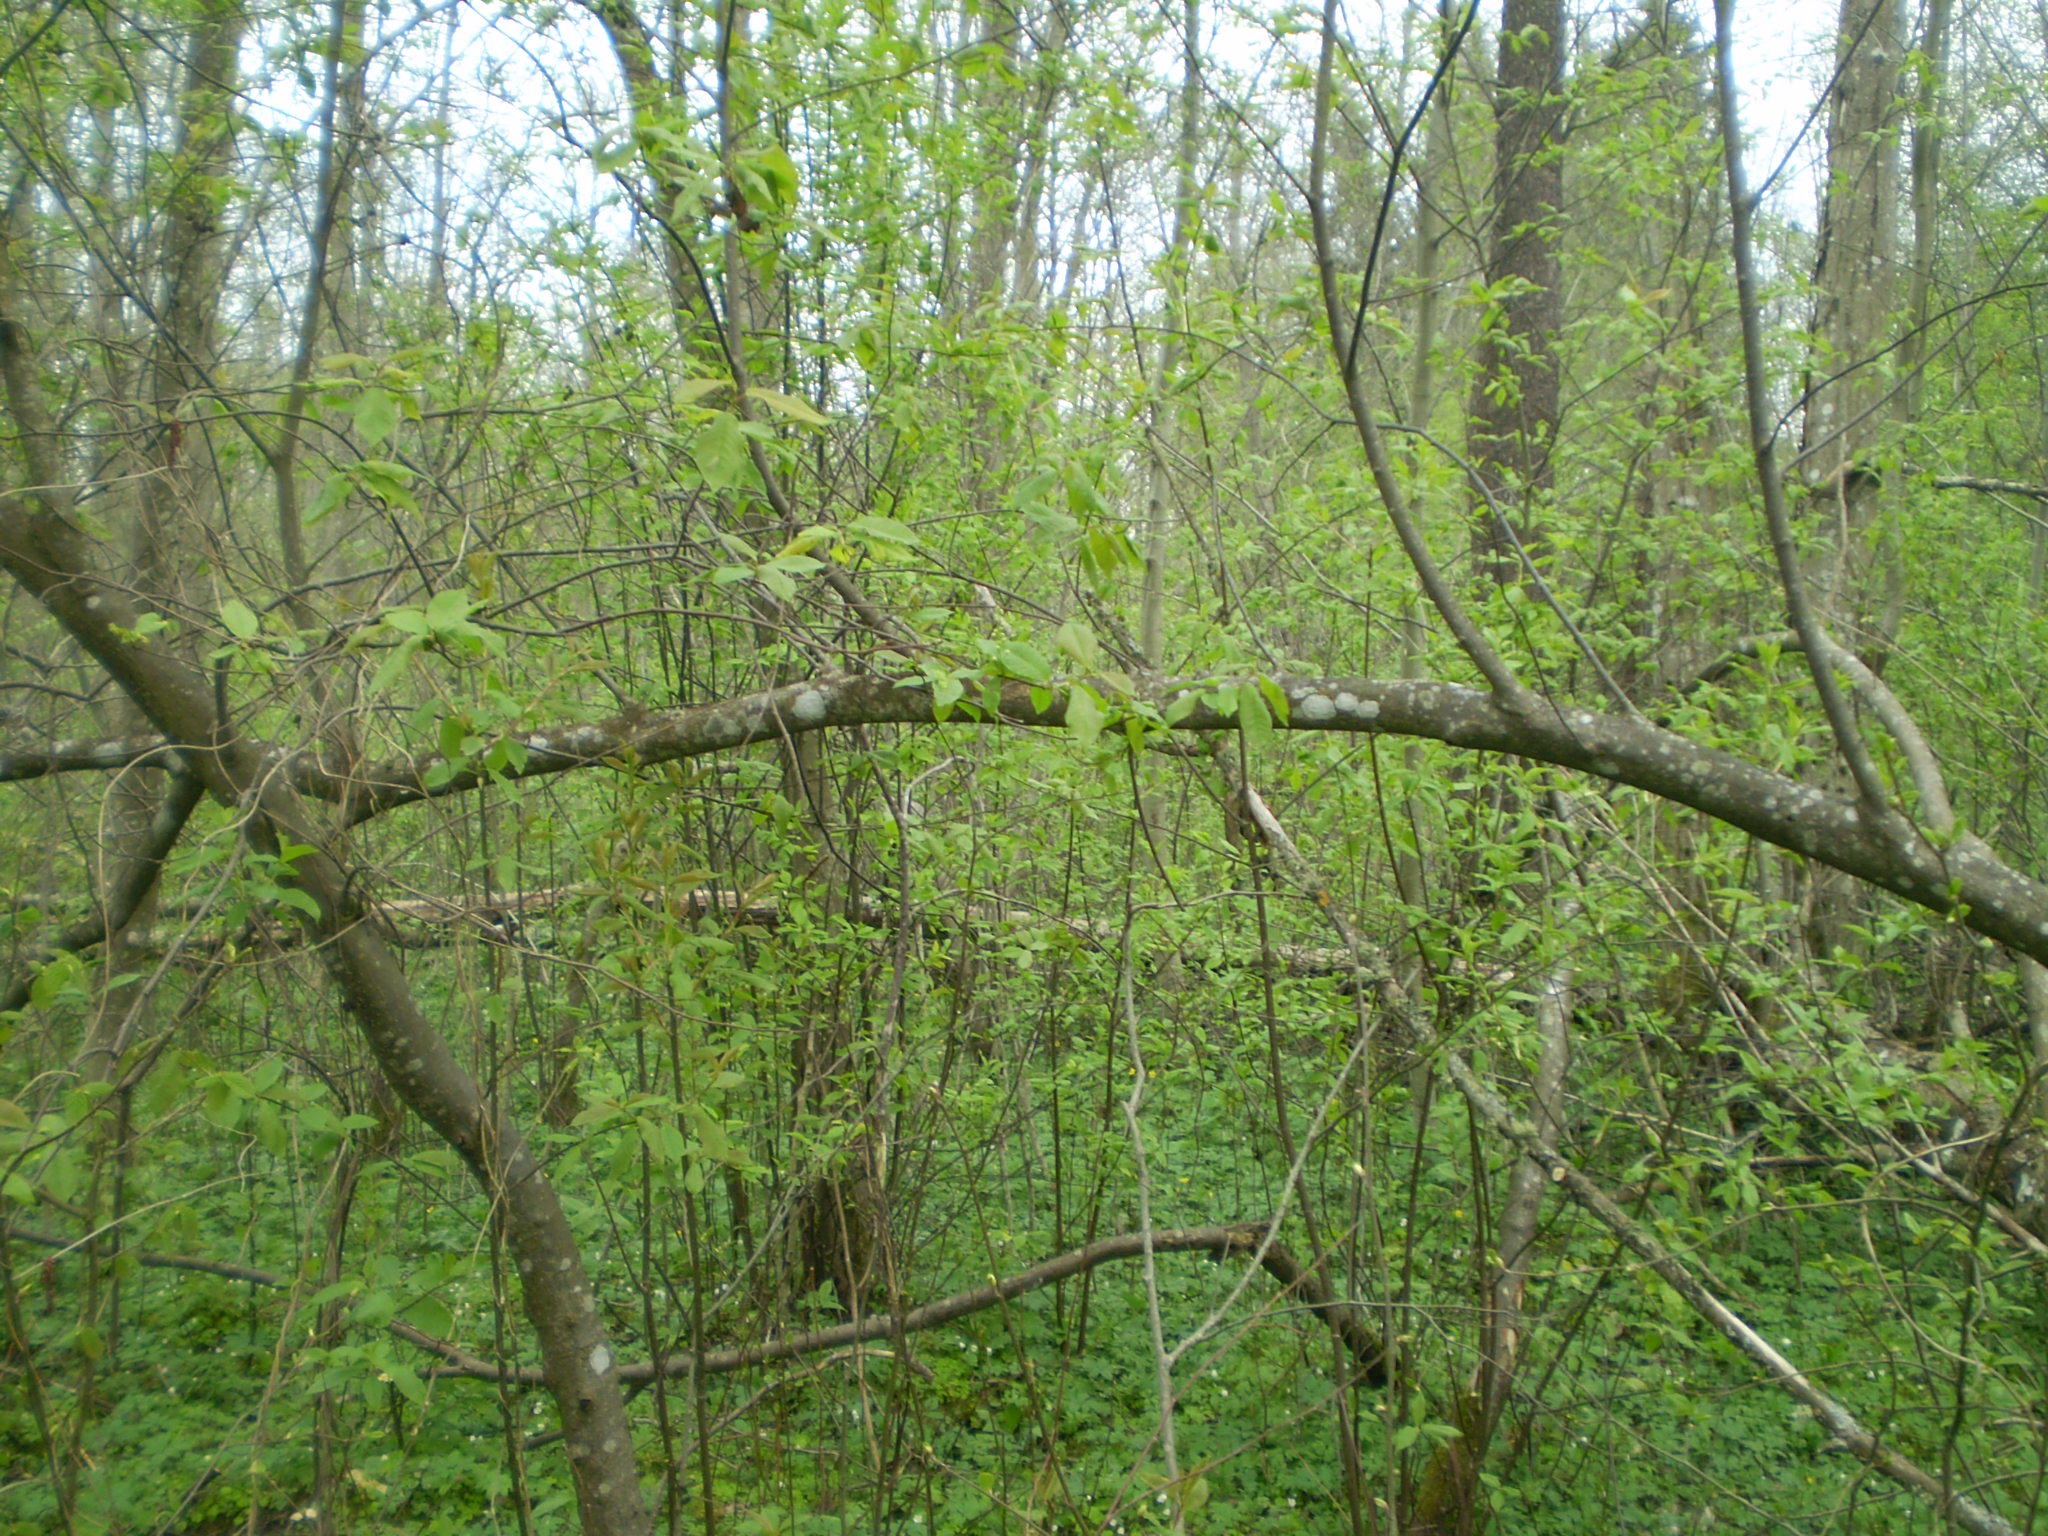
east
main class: Woodland
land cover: Broadleaved woodland
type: floodplain forest
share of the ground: 50 - 75 %
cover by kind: broadleaved forest trees 70 %, shrubs 25 %, herbaceous plants 5 %
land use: Semi-natural and natural areas not in use
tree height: > 5 m
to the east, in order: Broadleaved woodland; Inland fresh running water; Broadleaved woodland; Inland fresh running water; Broadleaved woodland; Inland fresh running water; Broadleaved woodland; Dry pulses
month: May
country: LT
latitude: 56.3551
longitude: 22.1413
